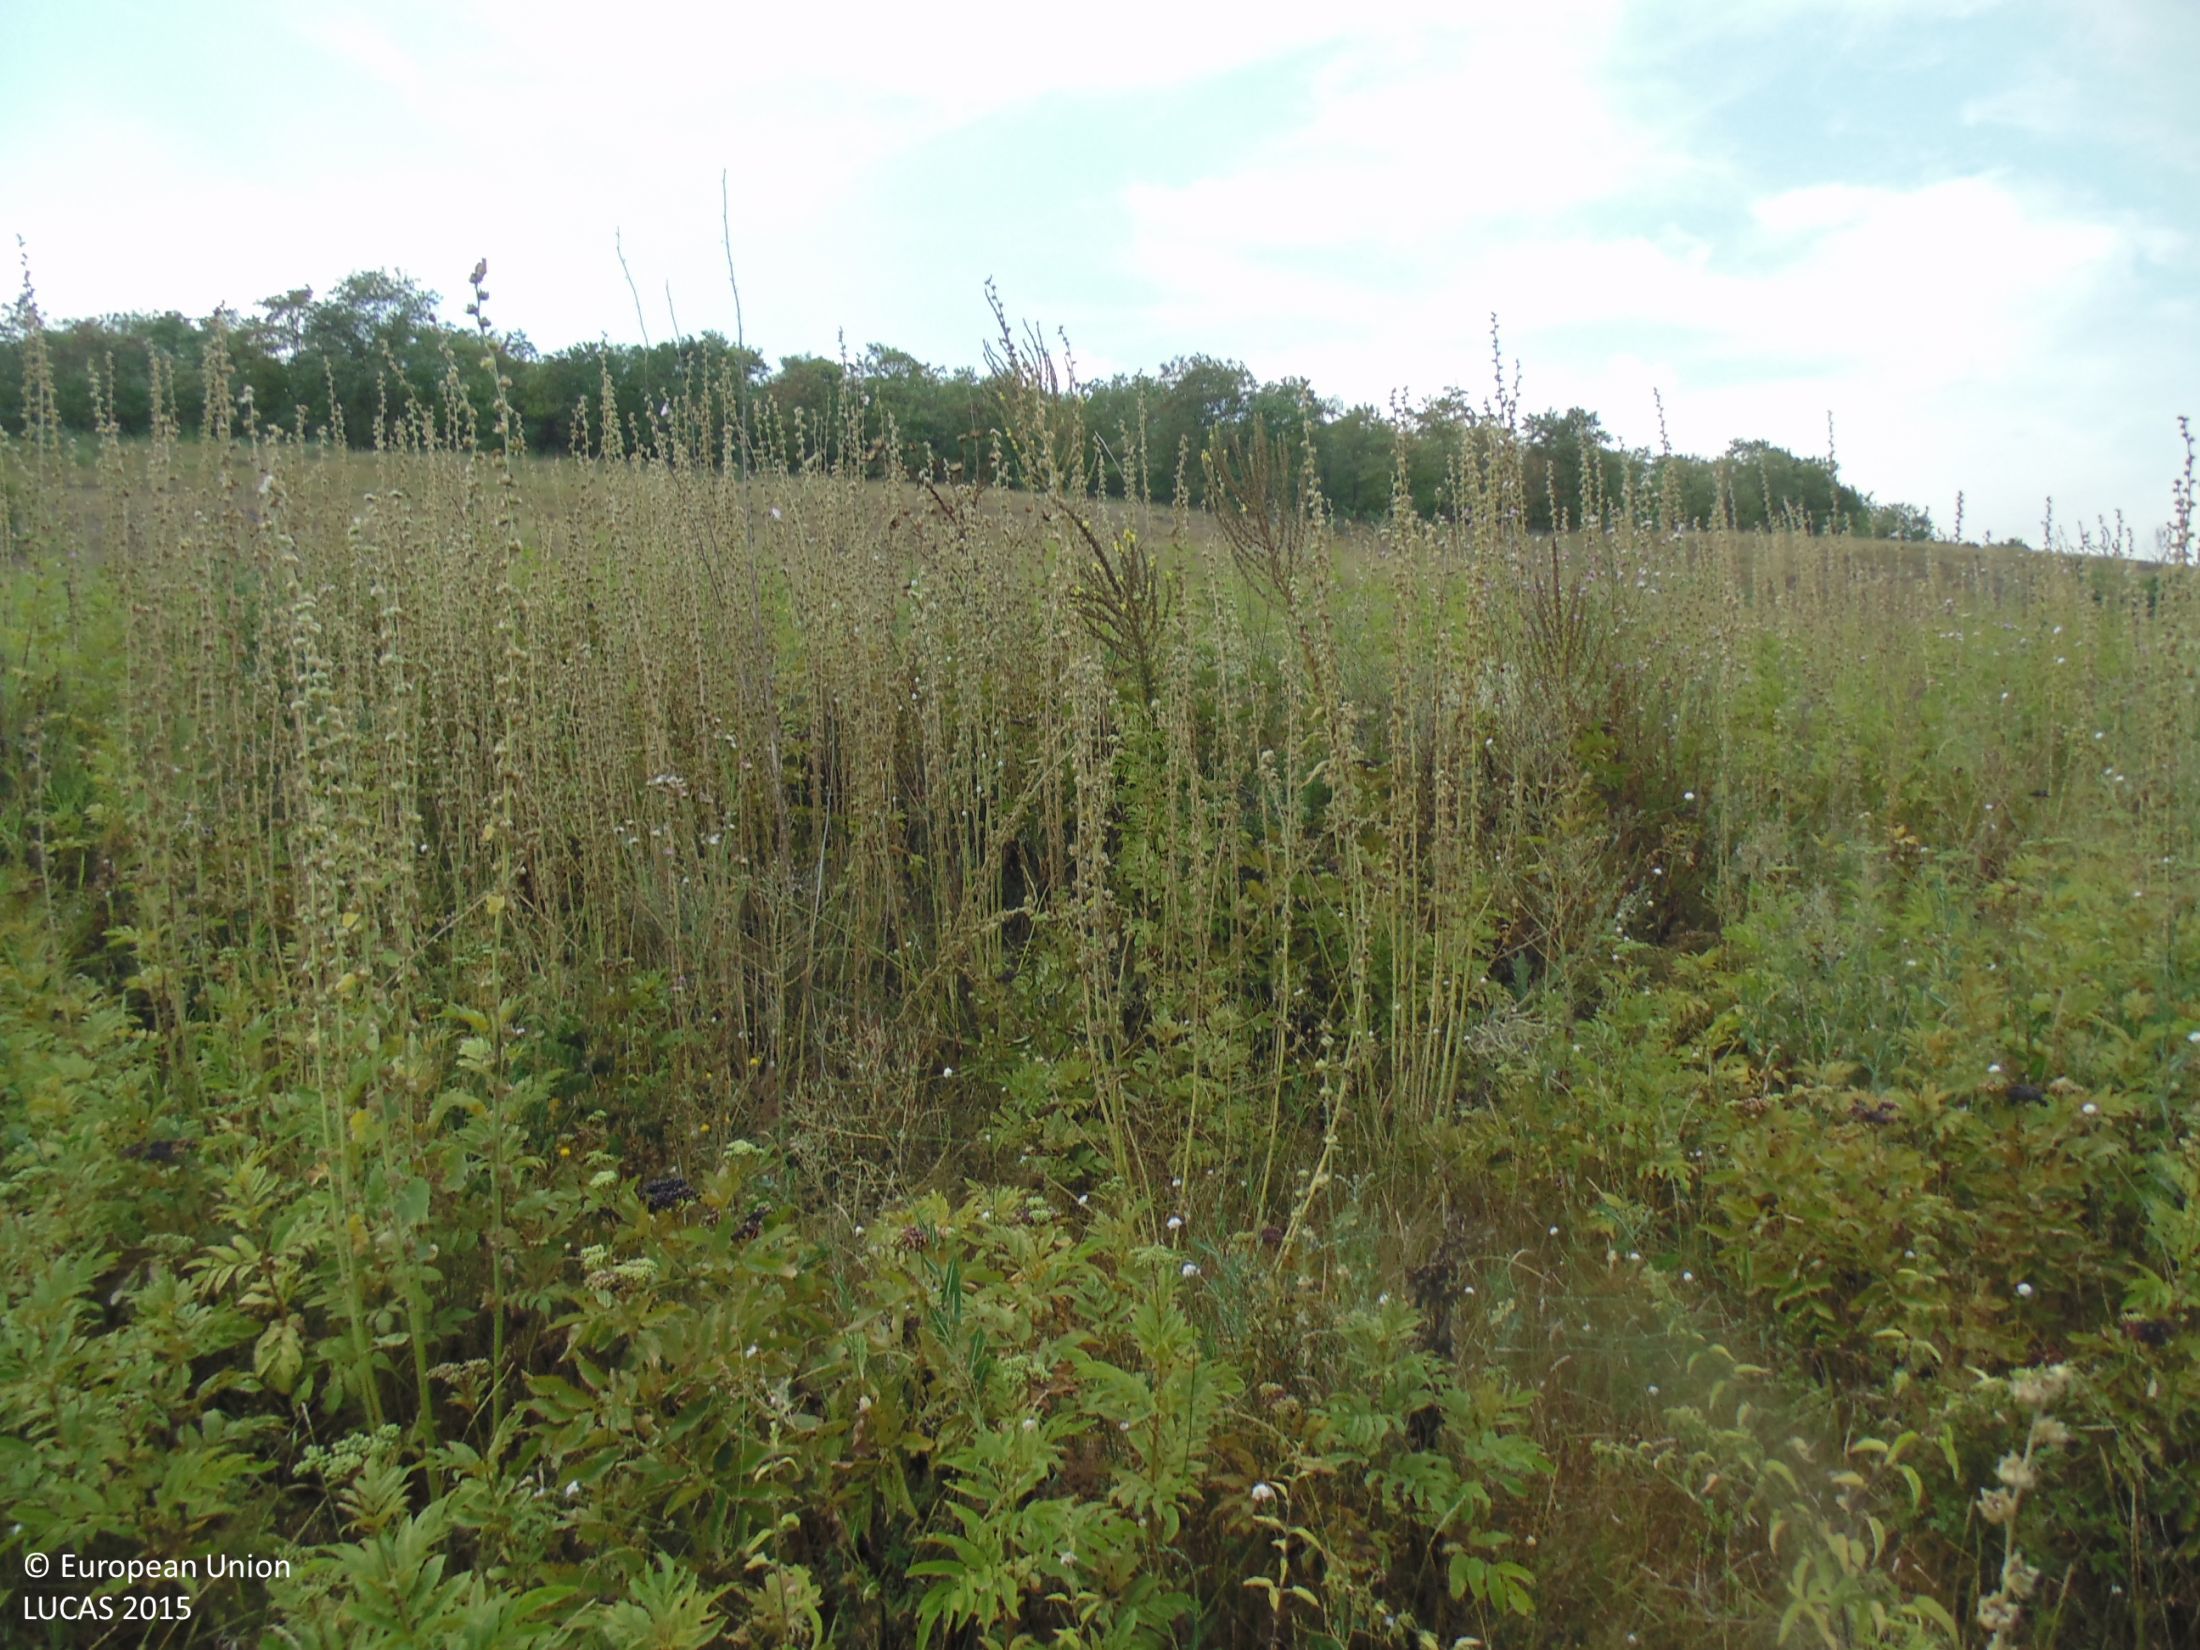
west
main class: Grassland
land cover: Grassland with sparse tree/shrub cover
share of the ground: > 75 %
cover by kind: herbaceous plants 85 %, shrubs 10 %, broadleaved forest trees 5 %
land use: Semi-natural and natural areas not in use
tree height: < 5 m
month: August
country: BG
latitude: 43.8830
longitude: 27.8061
